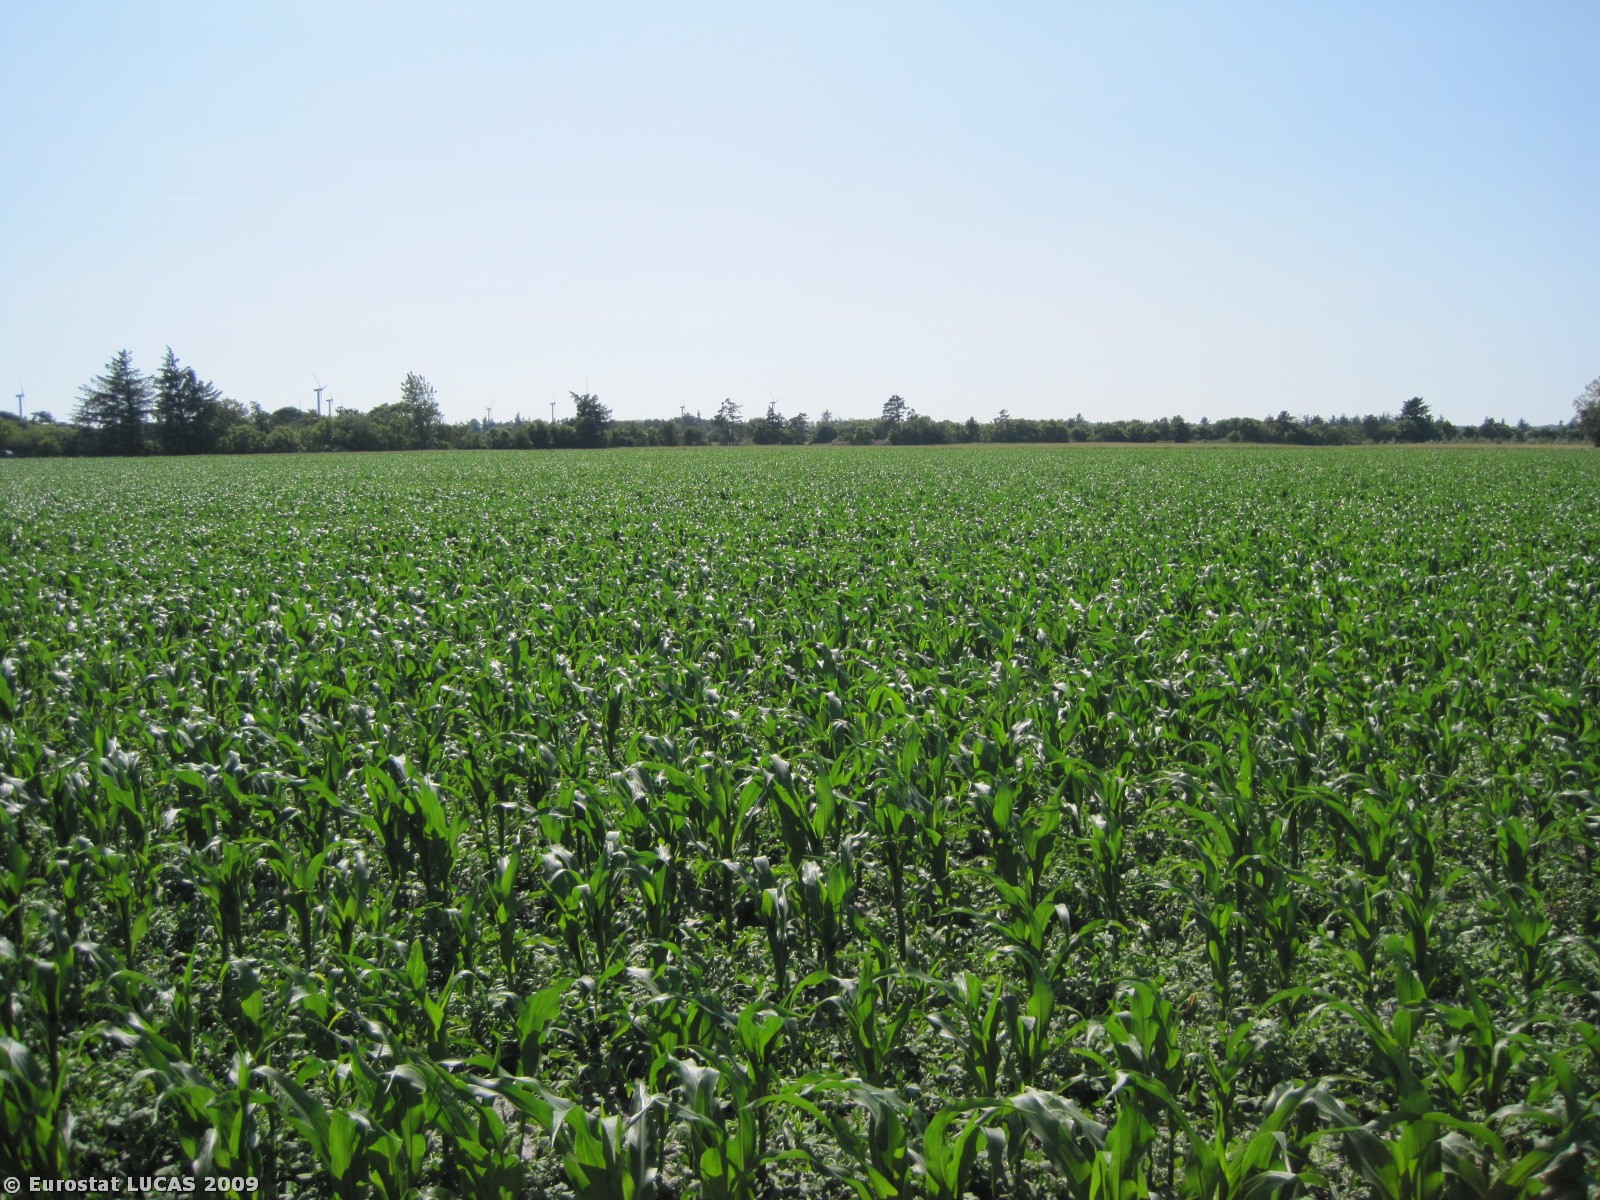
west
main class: Cropland
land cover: Maize
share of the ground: 25 - 50 %
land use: Agriculture (excluding fallow land and kitchen gardens)
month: July
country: DK
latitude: 56.3939
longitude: 8.4305
